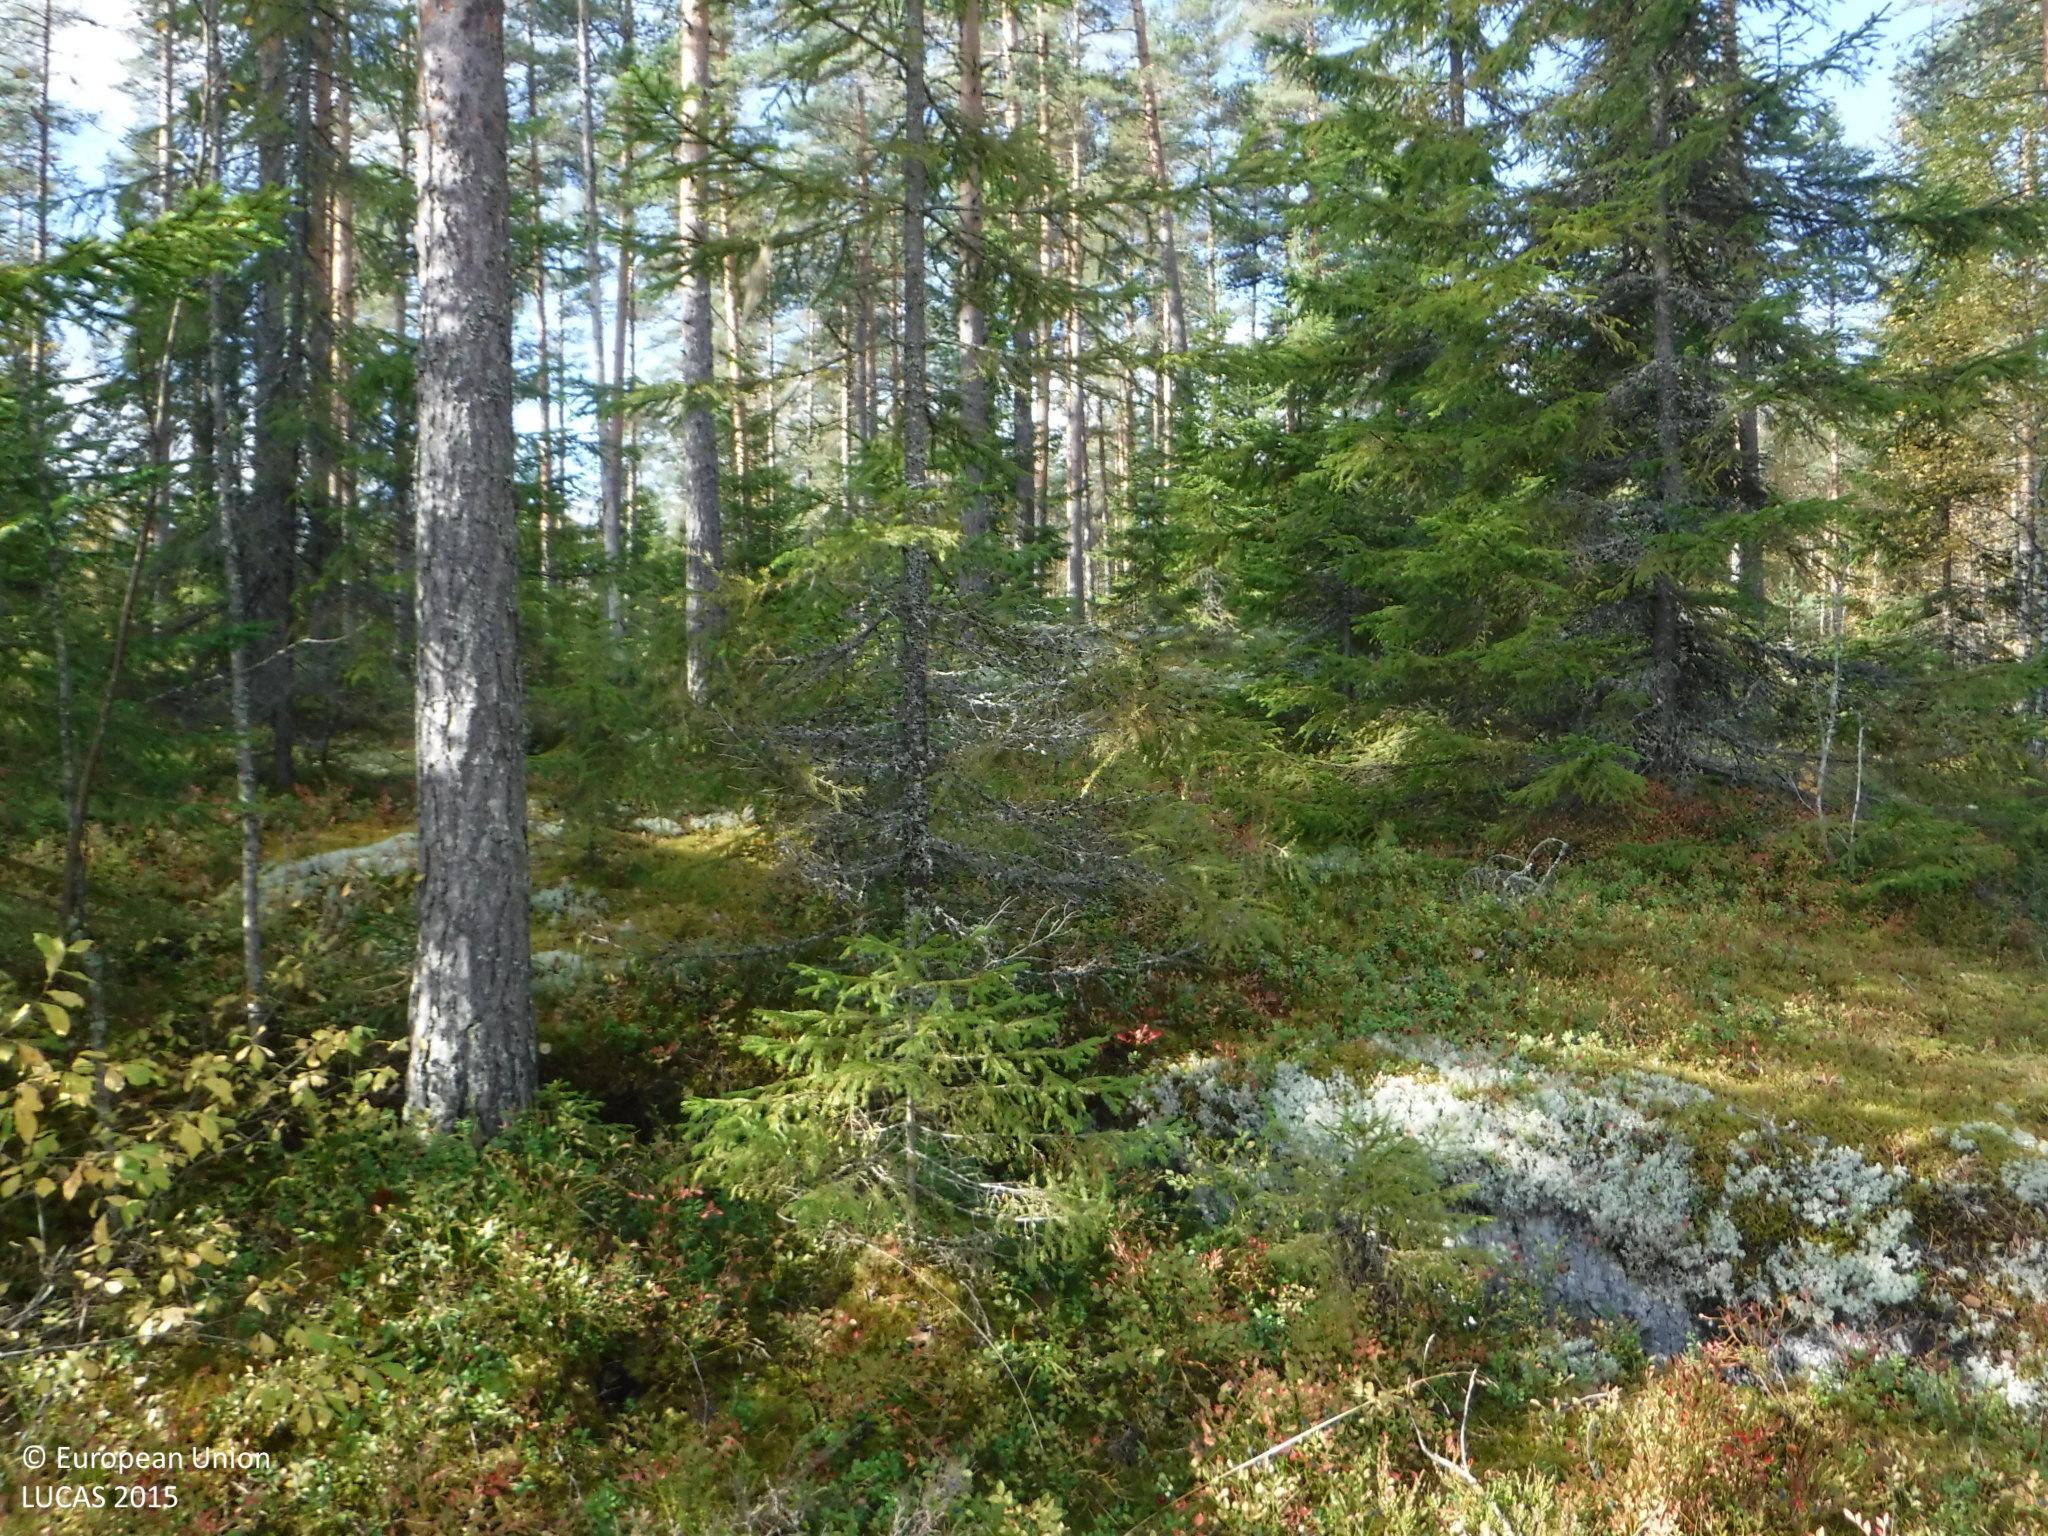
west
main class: Woodland
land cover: Other coniferous woodland
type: boreal forest
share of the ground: 25 - 50 %
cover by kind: shrubs 45 %, coniferous forest trees 30 %, lichens and mosses 25 %
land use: Forestry
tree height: > 5 m
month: September
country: FI
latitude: 61.5926
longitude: 24.1281
